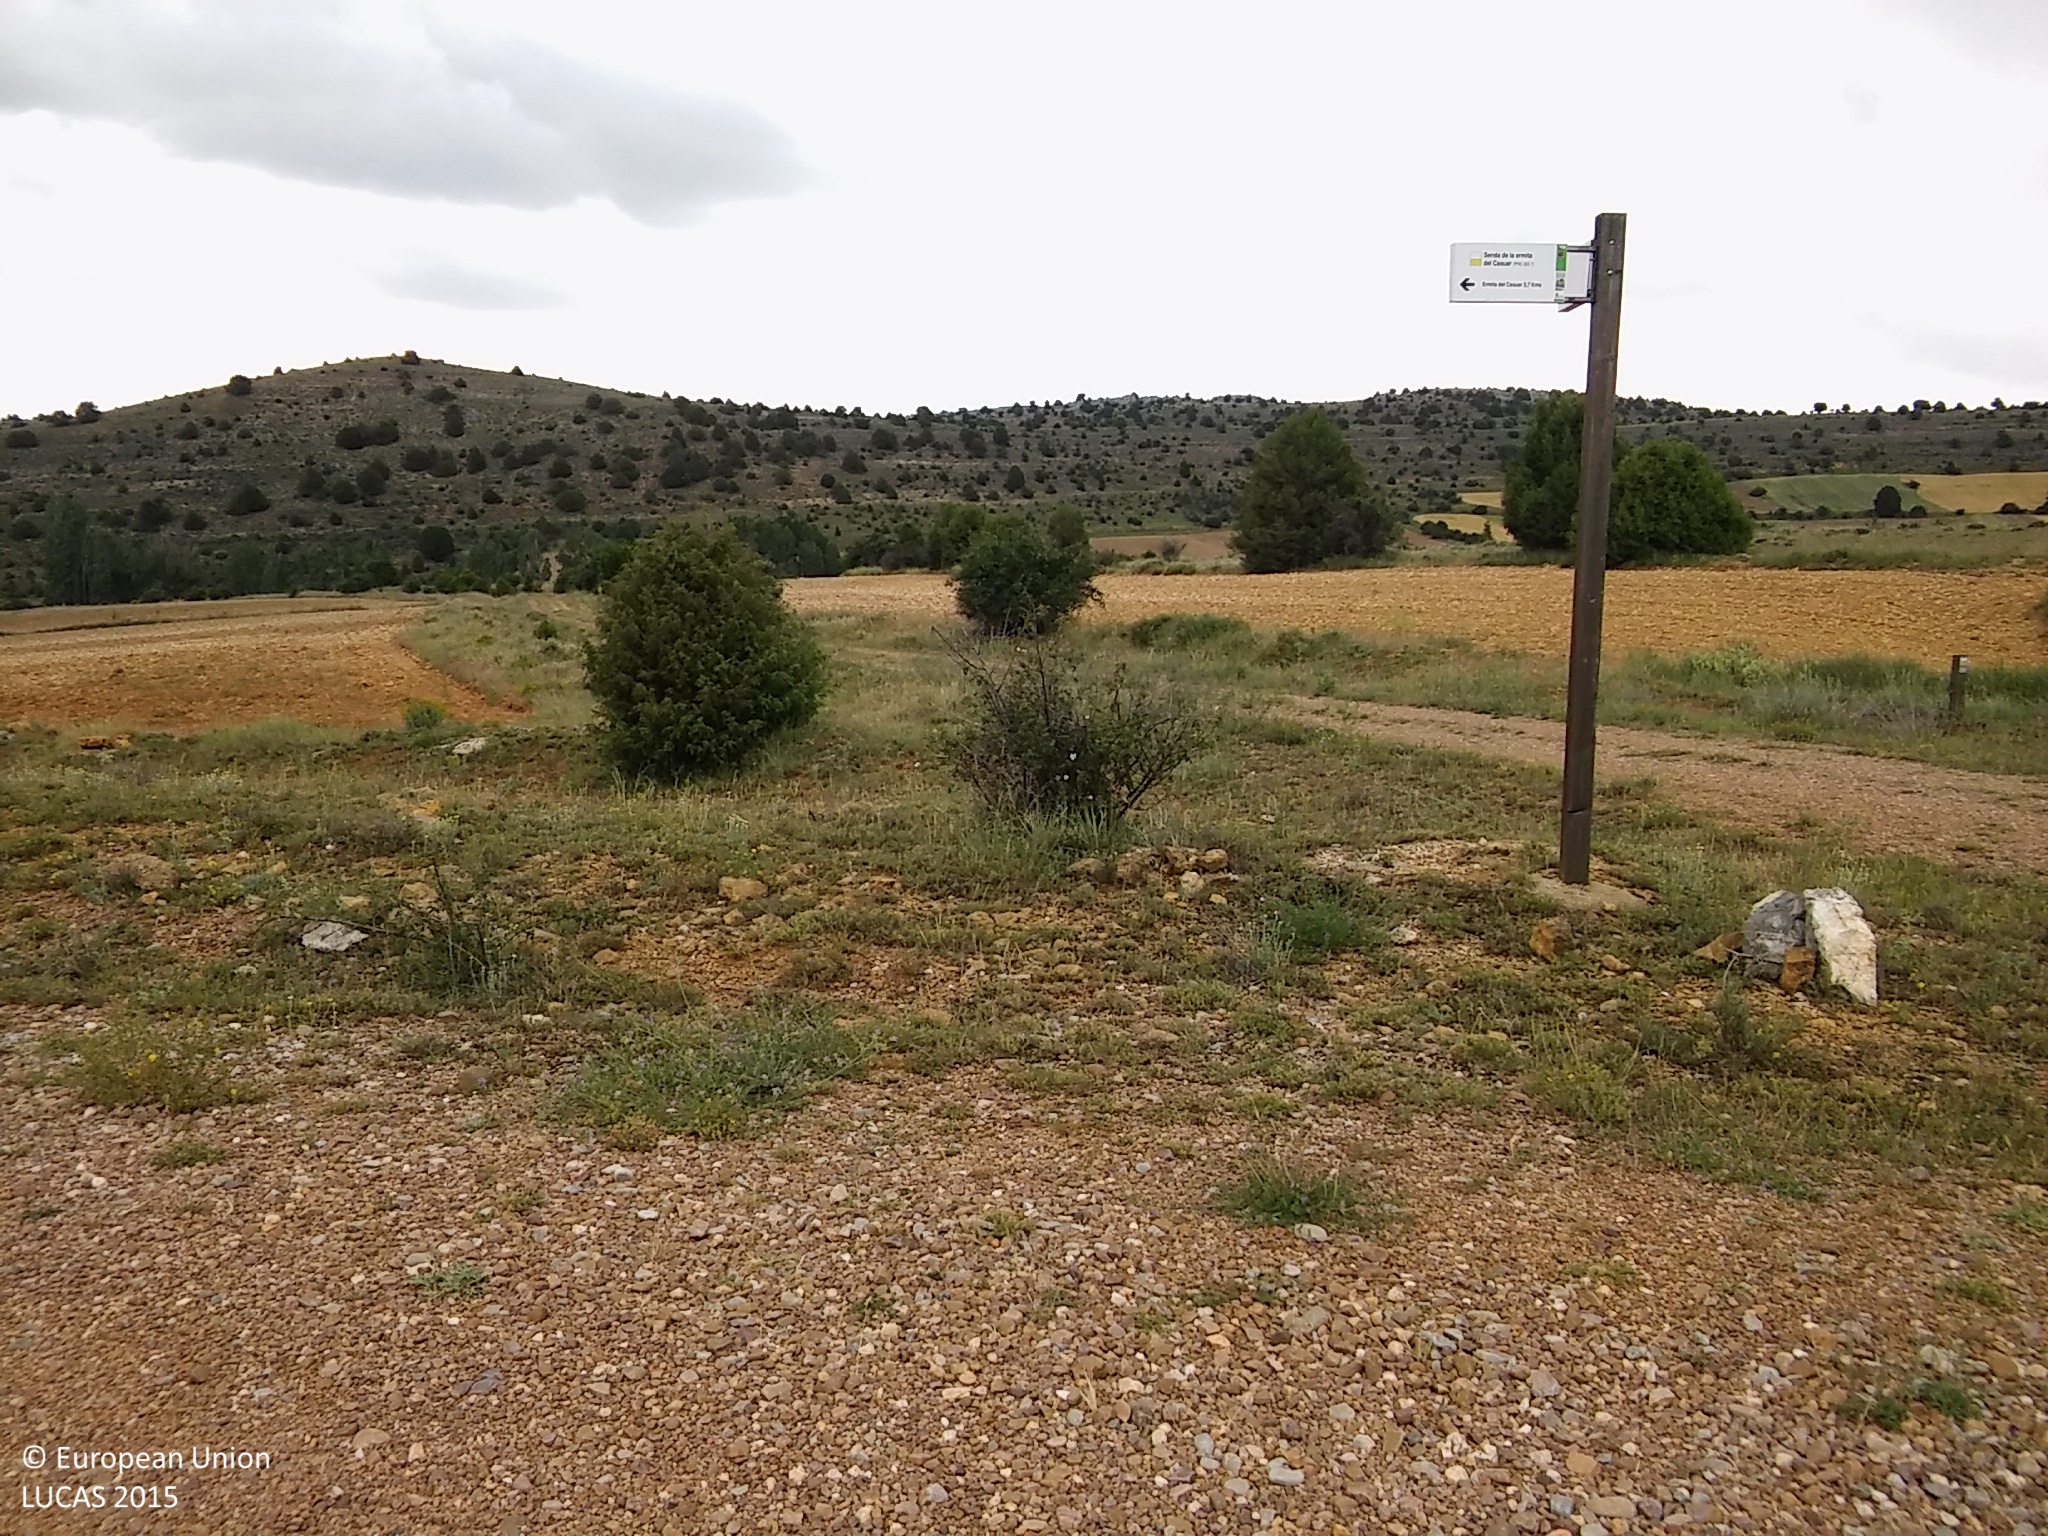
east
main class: Woodland
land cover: Other coniferous woodland
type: coniferous forest of the mediterranean region
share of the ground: 25 - 50 %
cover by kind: coniferous forest trees 30 %, herbaceous plants 25 %, unconsolidated bare surface 25 %, shrubs 20 %
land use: Forestry
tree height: > 5 m
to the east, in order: Other coniferous woodland
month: June
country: ES
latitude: 41.5300
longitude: -3.6050
